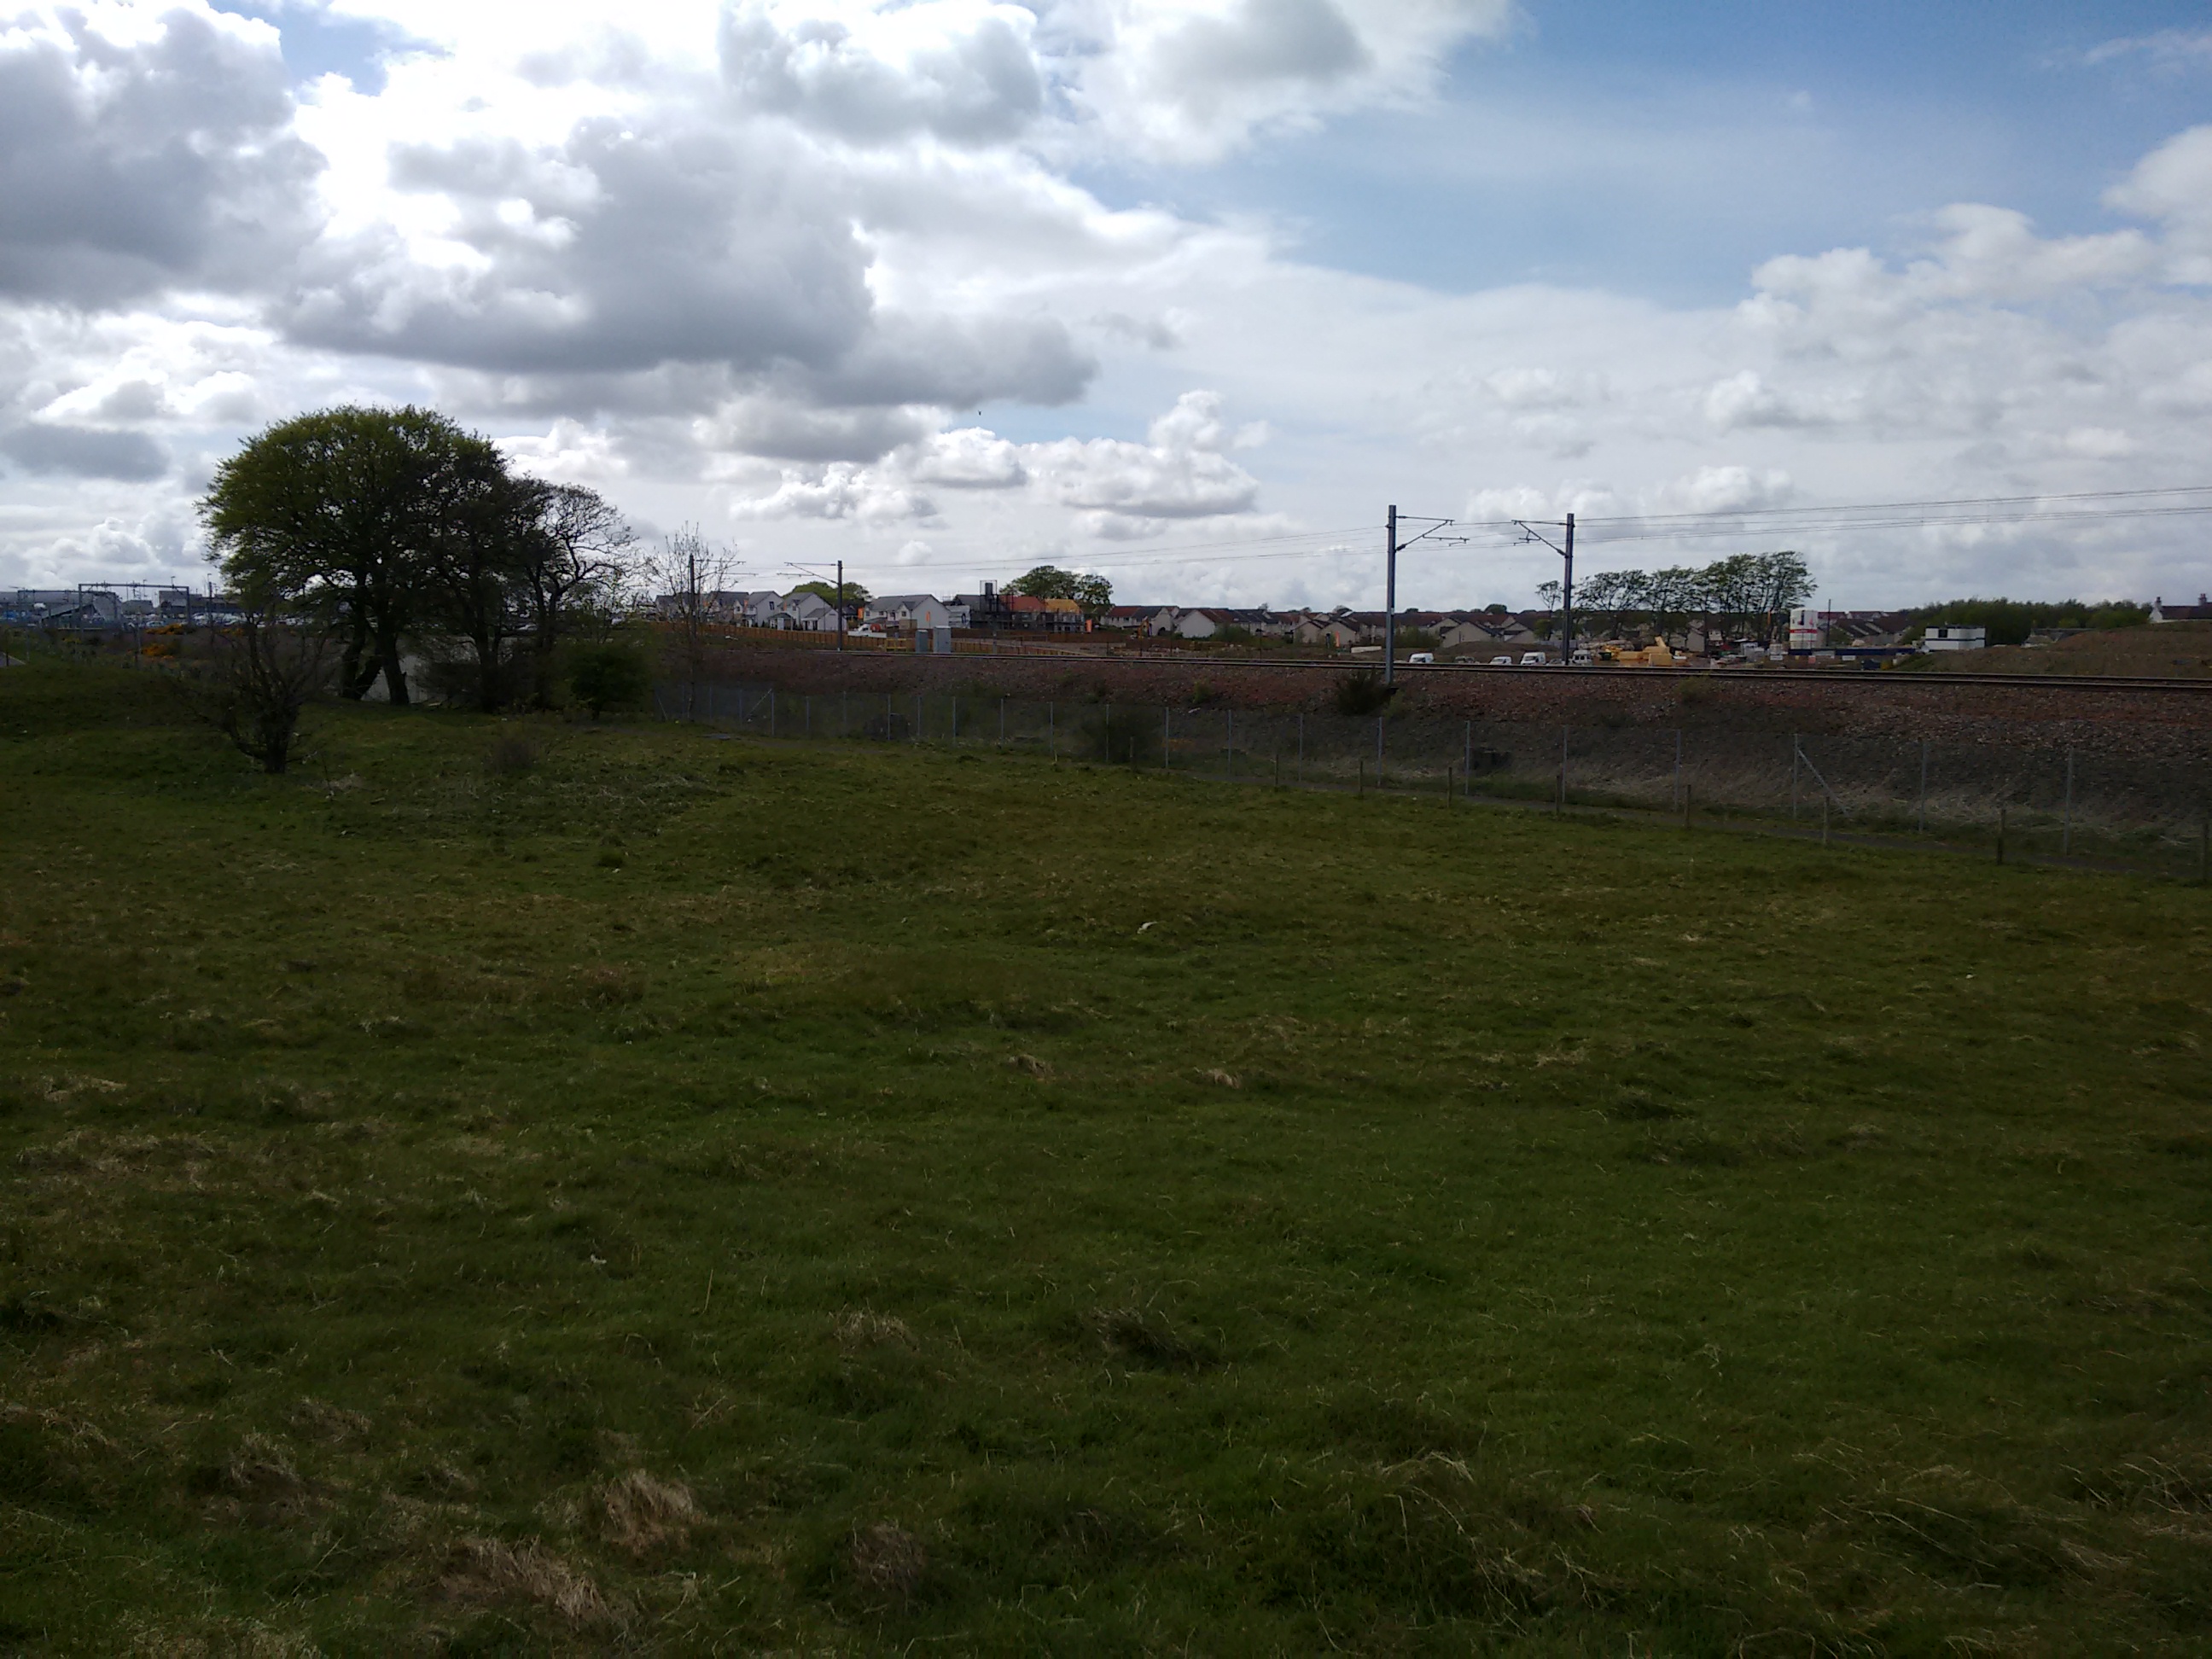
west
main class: Grassland
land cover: Grassland without tree/shrub cover
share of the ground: > 75 %
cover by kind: herbaceous plants 95 %, shrubs 5 %
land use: Agriculture (excluding fallow land and kitchen gardens)
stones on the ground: < 10 %
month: May
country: GB
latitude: 55.8880
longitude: -3.6875
